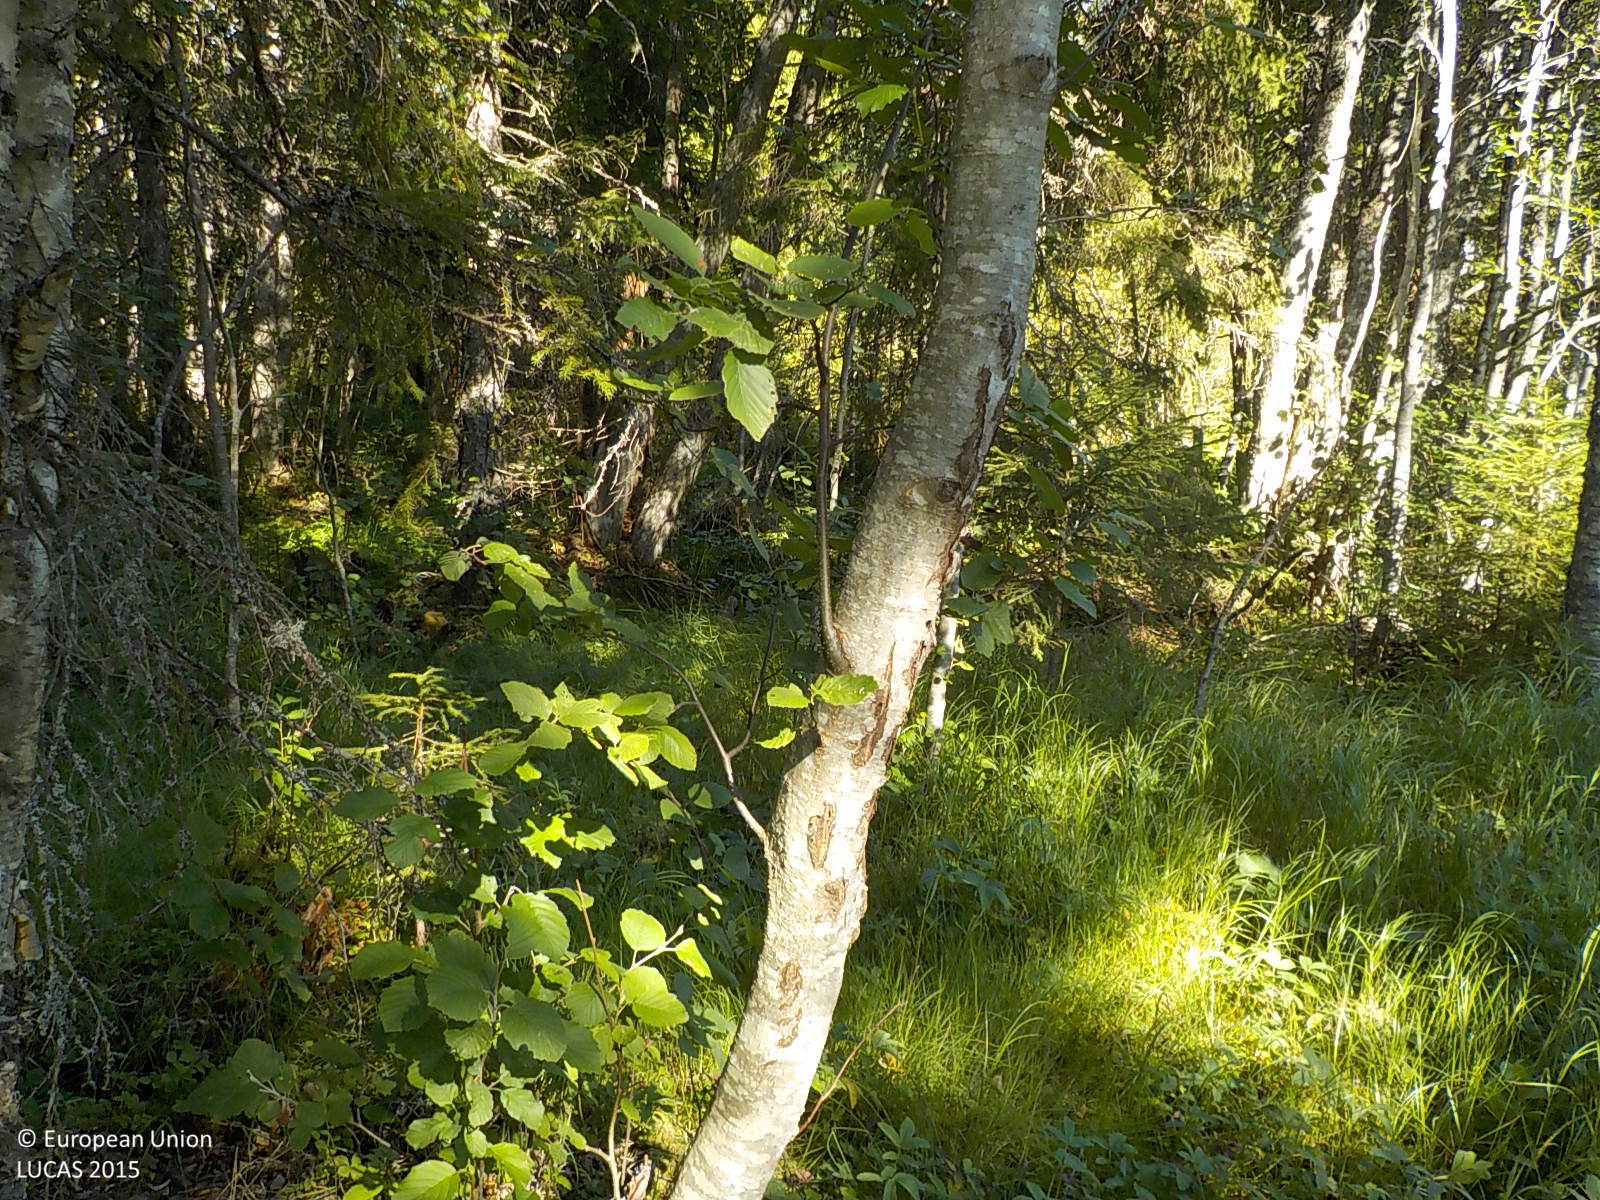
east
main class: Woodland
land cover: Spruce dominated coniferous woodland
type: boreal forest
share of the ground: > 75 %
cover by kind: coniferous forest trees 85 %, herbaceous plants 15 %
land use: Forestry
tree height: > 5 m
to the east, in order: Spruce dominated coniferous woodland; Other mixed woodland; Broadleaved woodland; Spruce dominated mixed woodland; Spruce dominated coniferous woodland; Tracks; Spruce dominated coniferous woodland
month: August
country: SE
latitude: 63.3966
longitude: 18.6841
